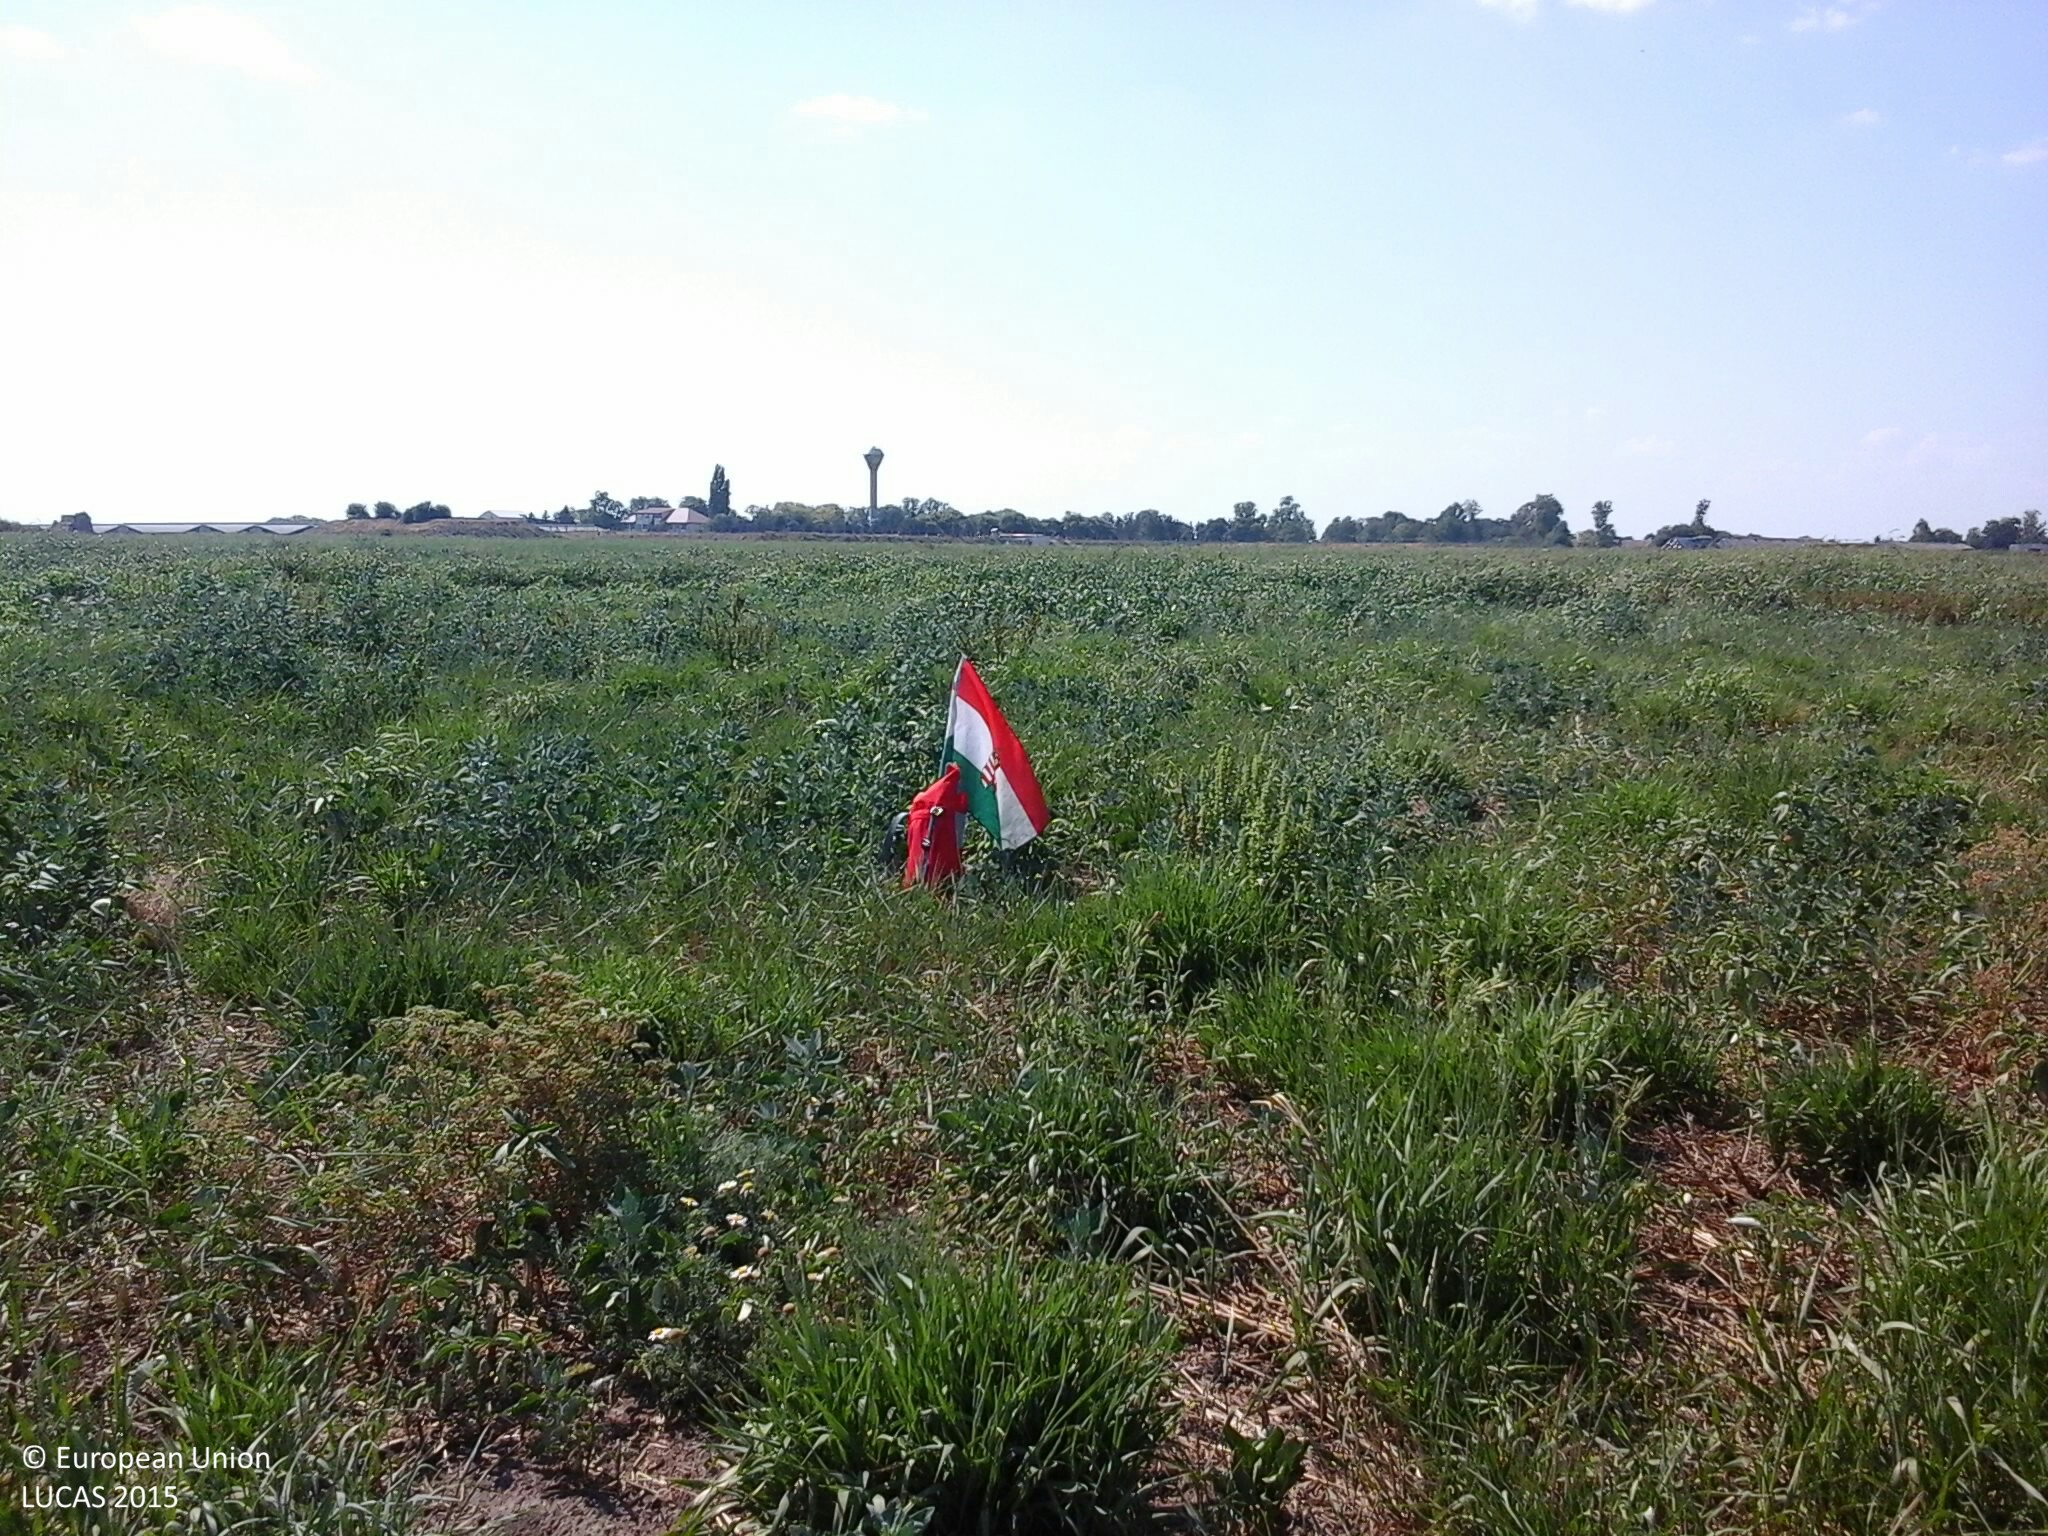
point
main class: Grassland
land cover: Spontaneously vegetated surfaces
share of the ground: > 75 %
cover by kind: herbaceous plants 90 %, unconsolidated bare surface 10 %
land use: Fallow land
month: July
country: HU
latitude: 47.0365
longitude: 18.3681
